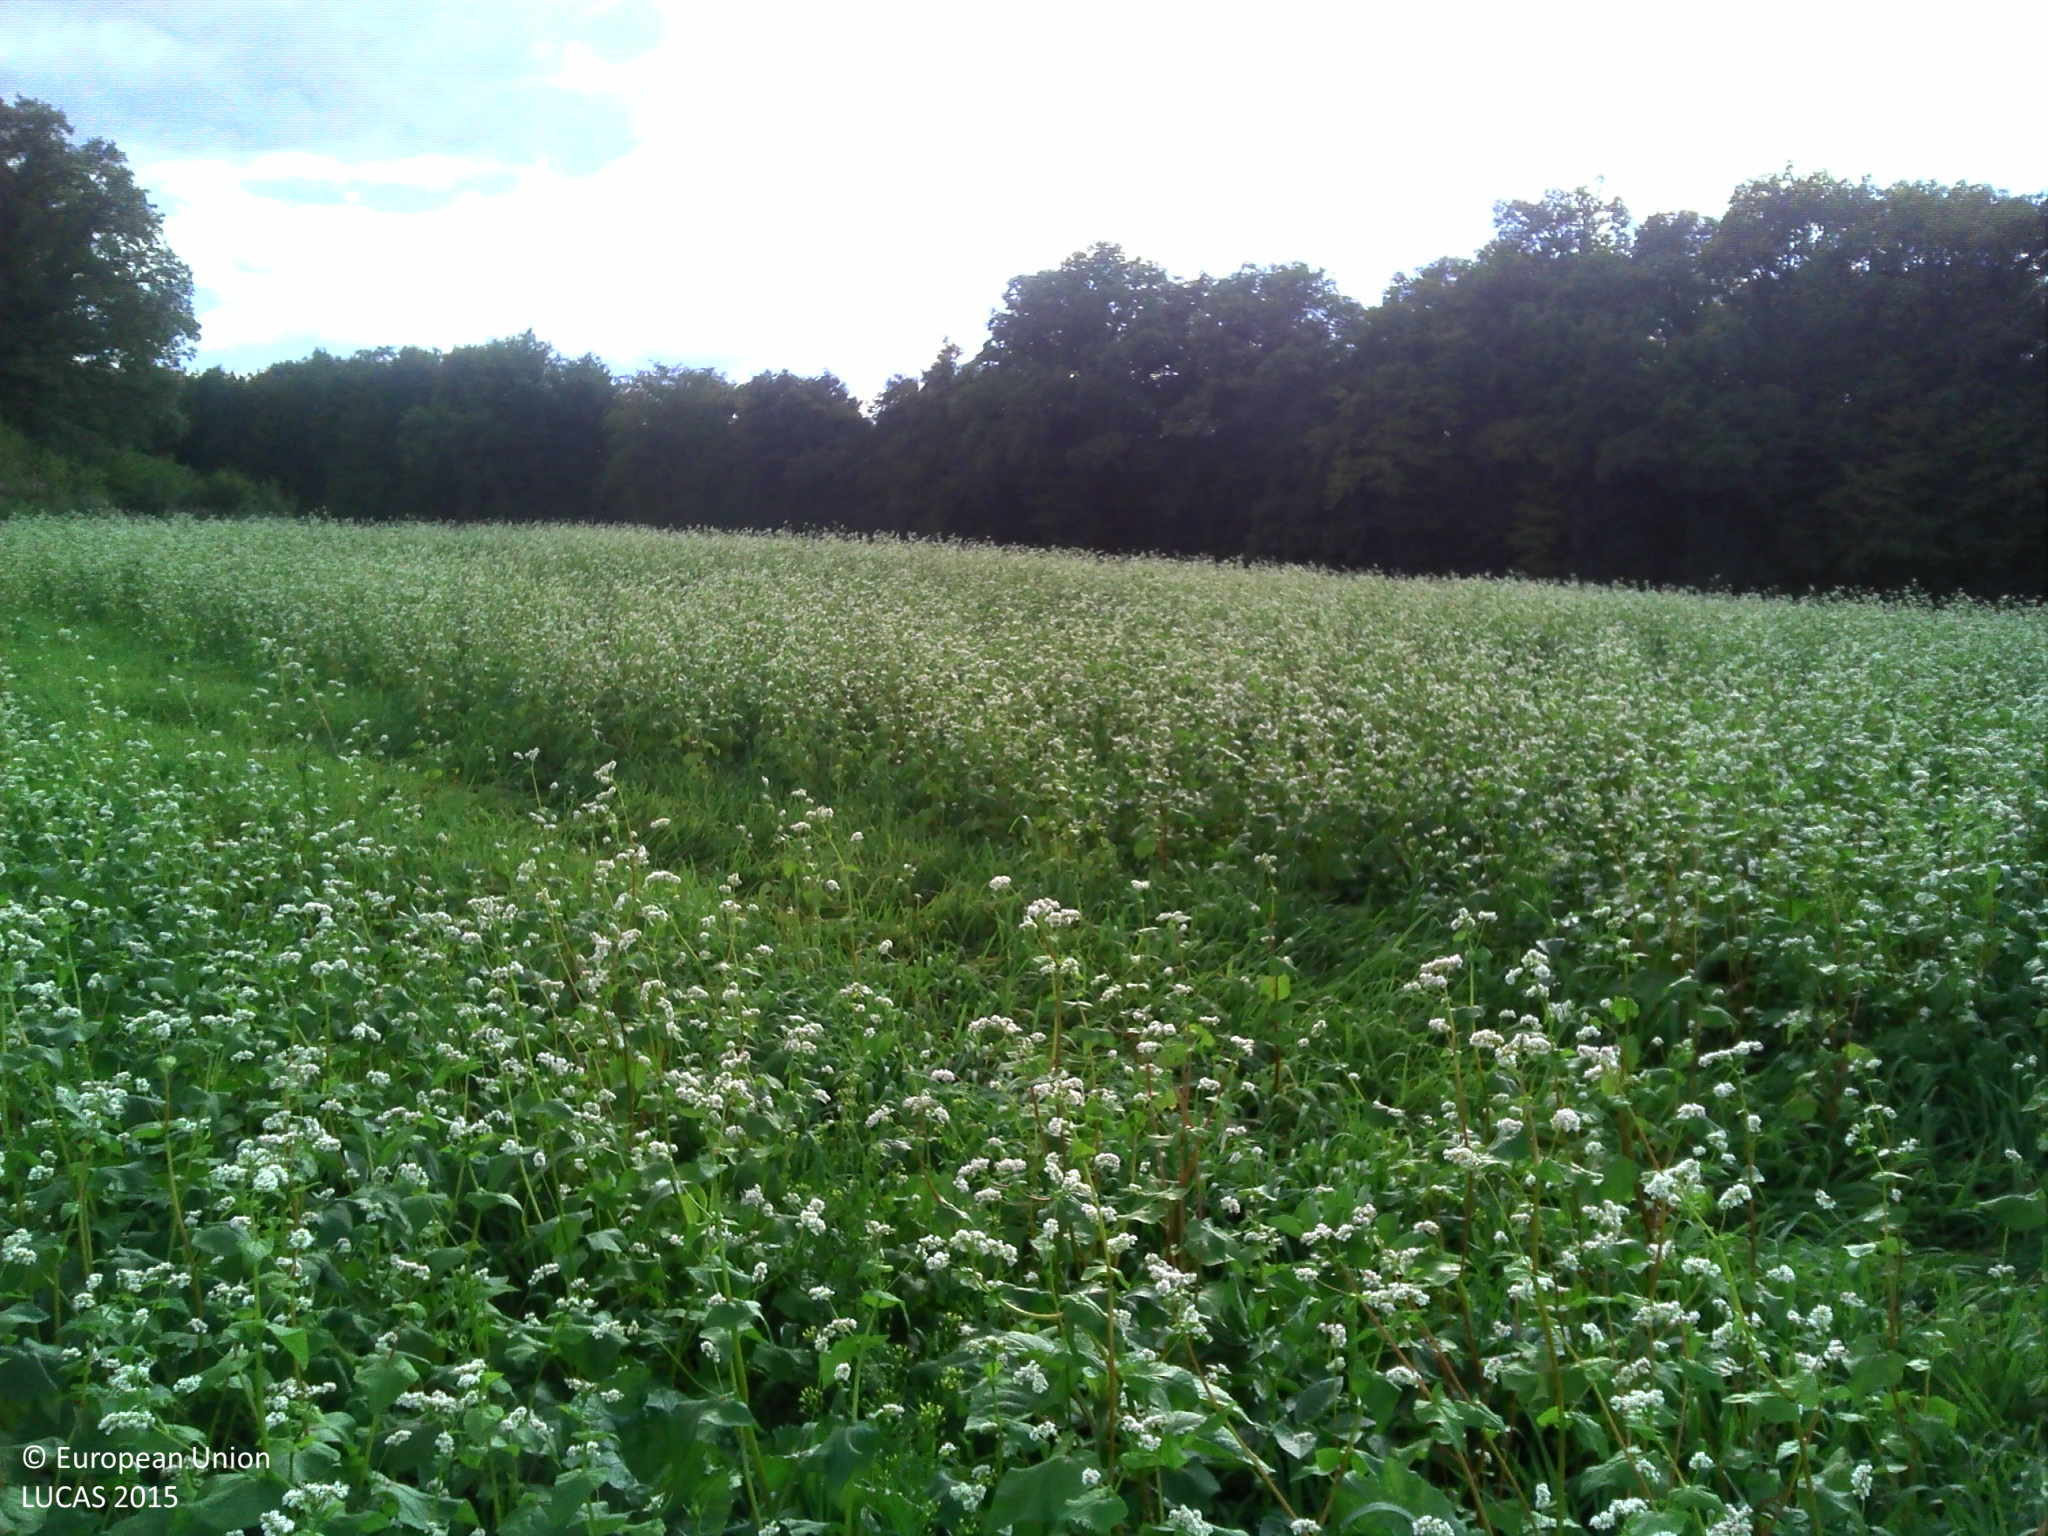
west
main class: Cropland
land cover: Other cereals
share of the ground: > 75 %
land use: Agriculture (excluding fallow land and kitchen gardens)
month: September
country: FR
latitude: 47.4067
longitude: 6.3574
